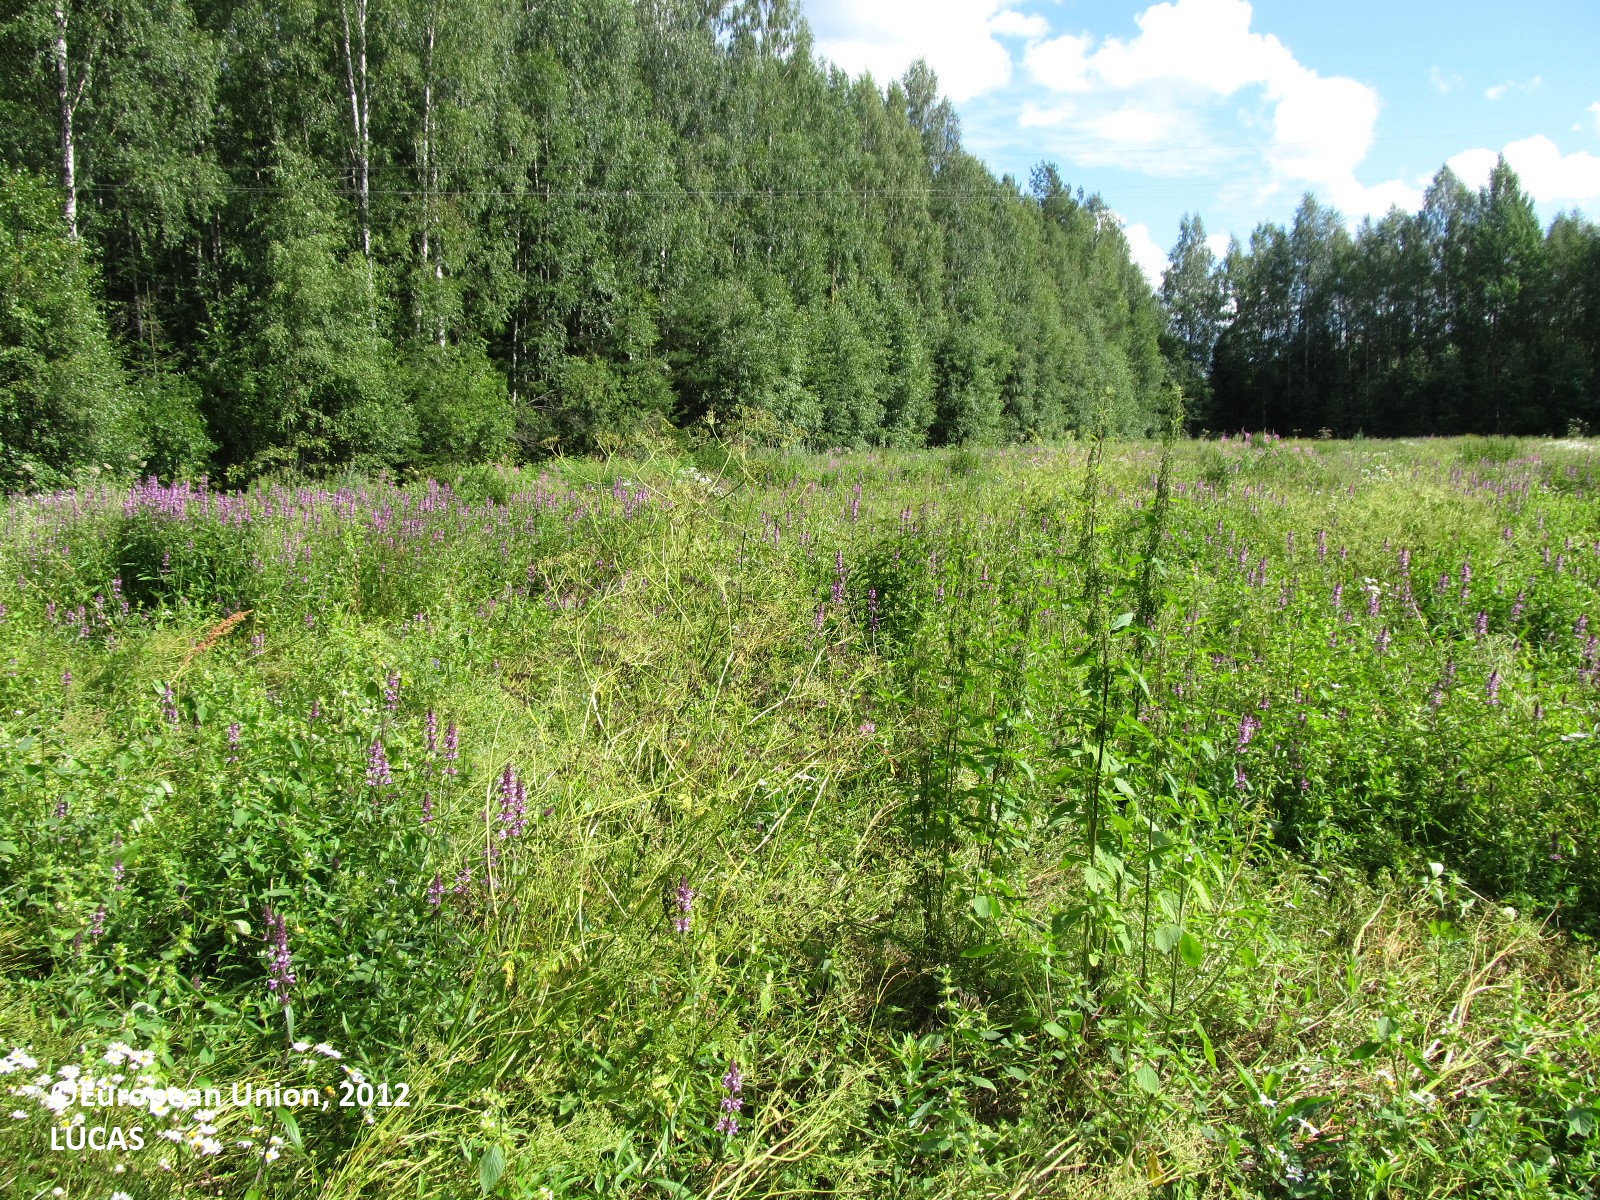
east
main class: Grassland
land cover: Grassland without tree/shrub cover
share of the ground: > 75 %
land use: Fallow land
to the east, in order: Grassland without tree/shrub cover; Ditches and canals; Spruce dominated mixed woodland; Electric lines; Grassland without tree/shrub cover; Spruce dominated coniferous woodland; Tracks; Spruce dominated coniferous woodland; Tracks; Spruce dominated mixed woodland
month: July
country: FI
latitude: 61.9300
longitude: 28.0806
